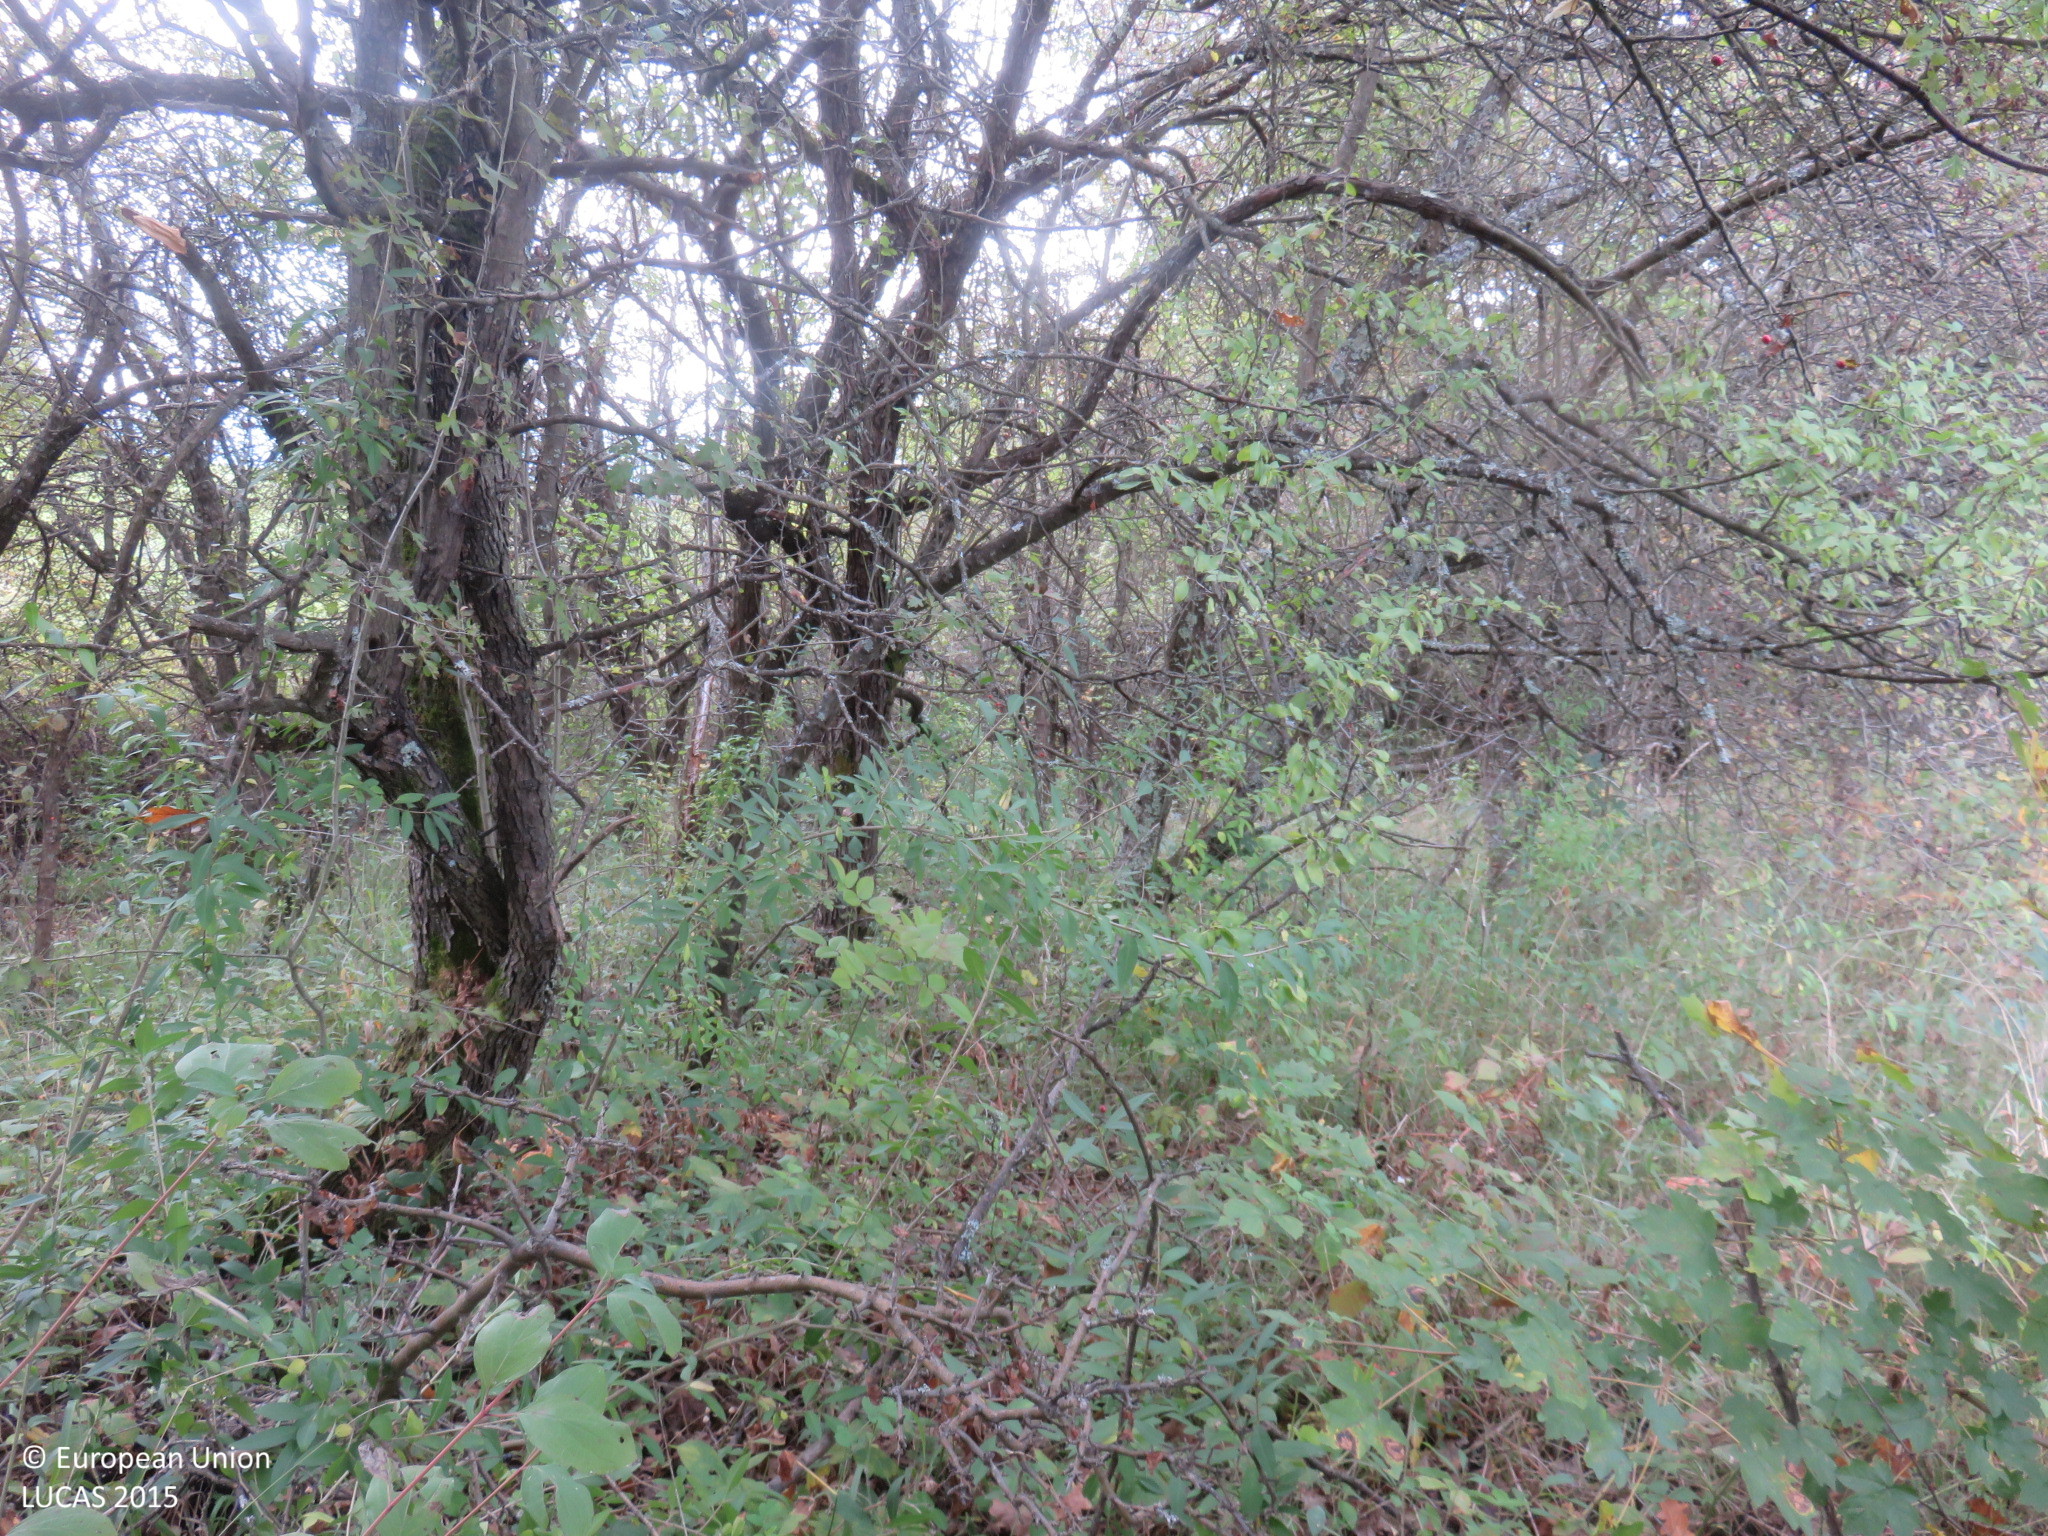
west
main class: Woodland
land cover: Broadleaved woodland
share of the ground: > 75 %
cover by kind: broadleaved forest trees 90 %, shrubs 5 %, herbaceous plants 5 %
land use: Semi-natural and natural areas not in use
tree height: < 5 m
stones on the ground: < 10 %
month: October
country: BG
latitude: 42.9119
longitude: 25.1966
